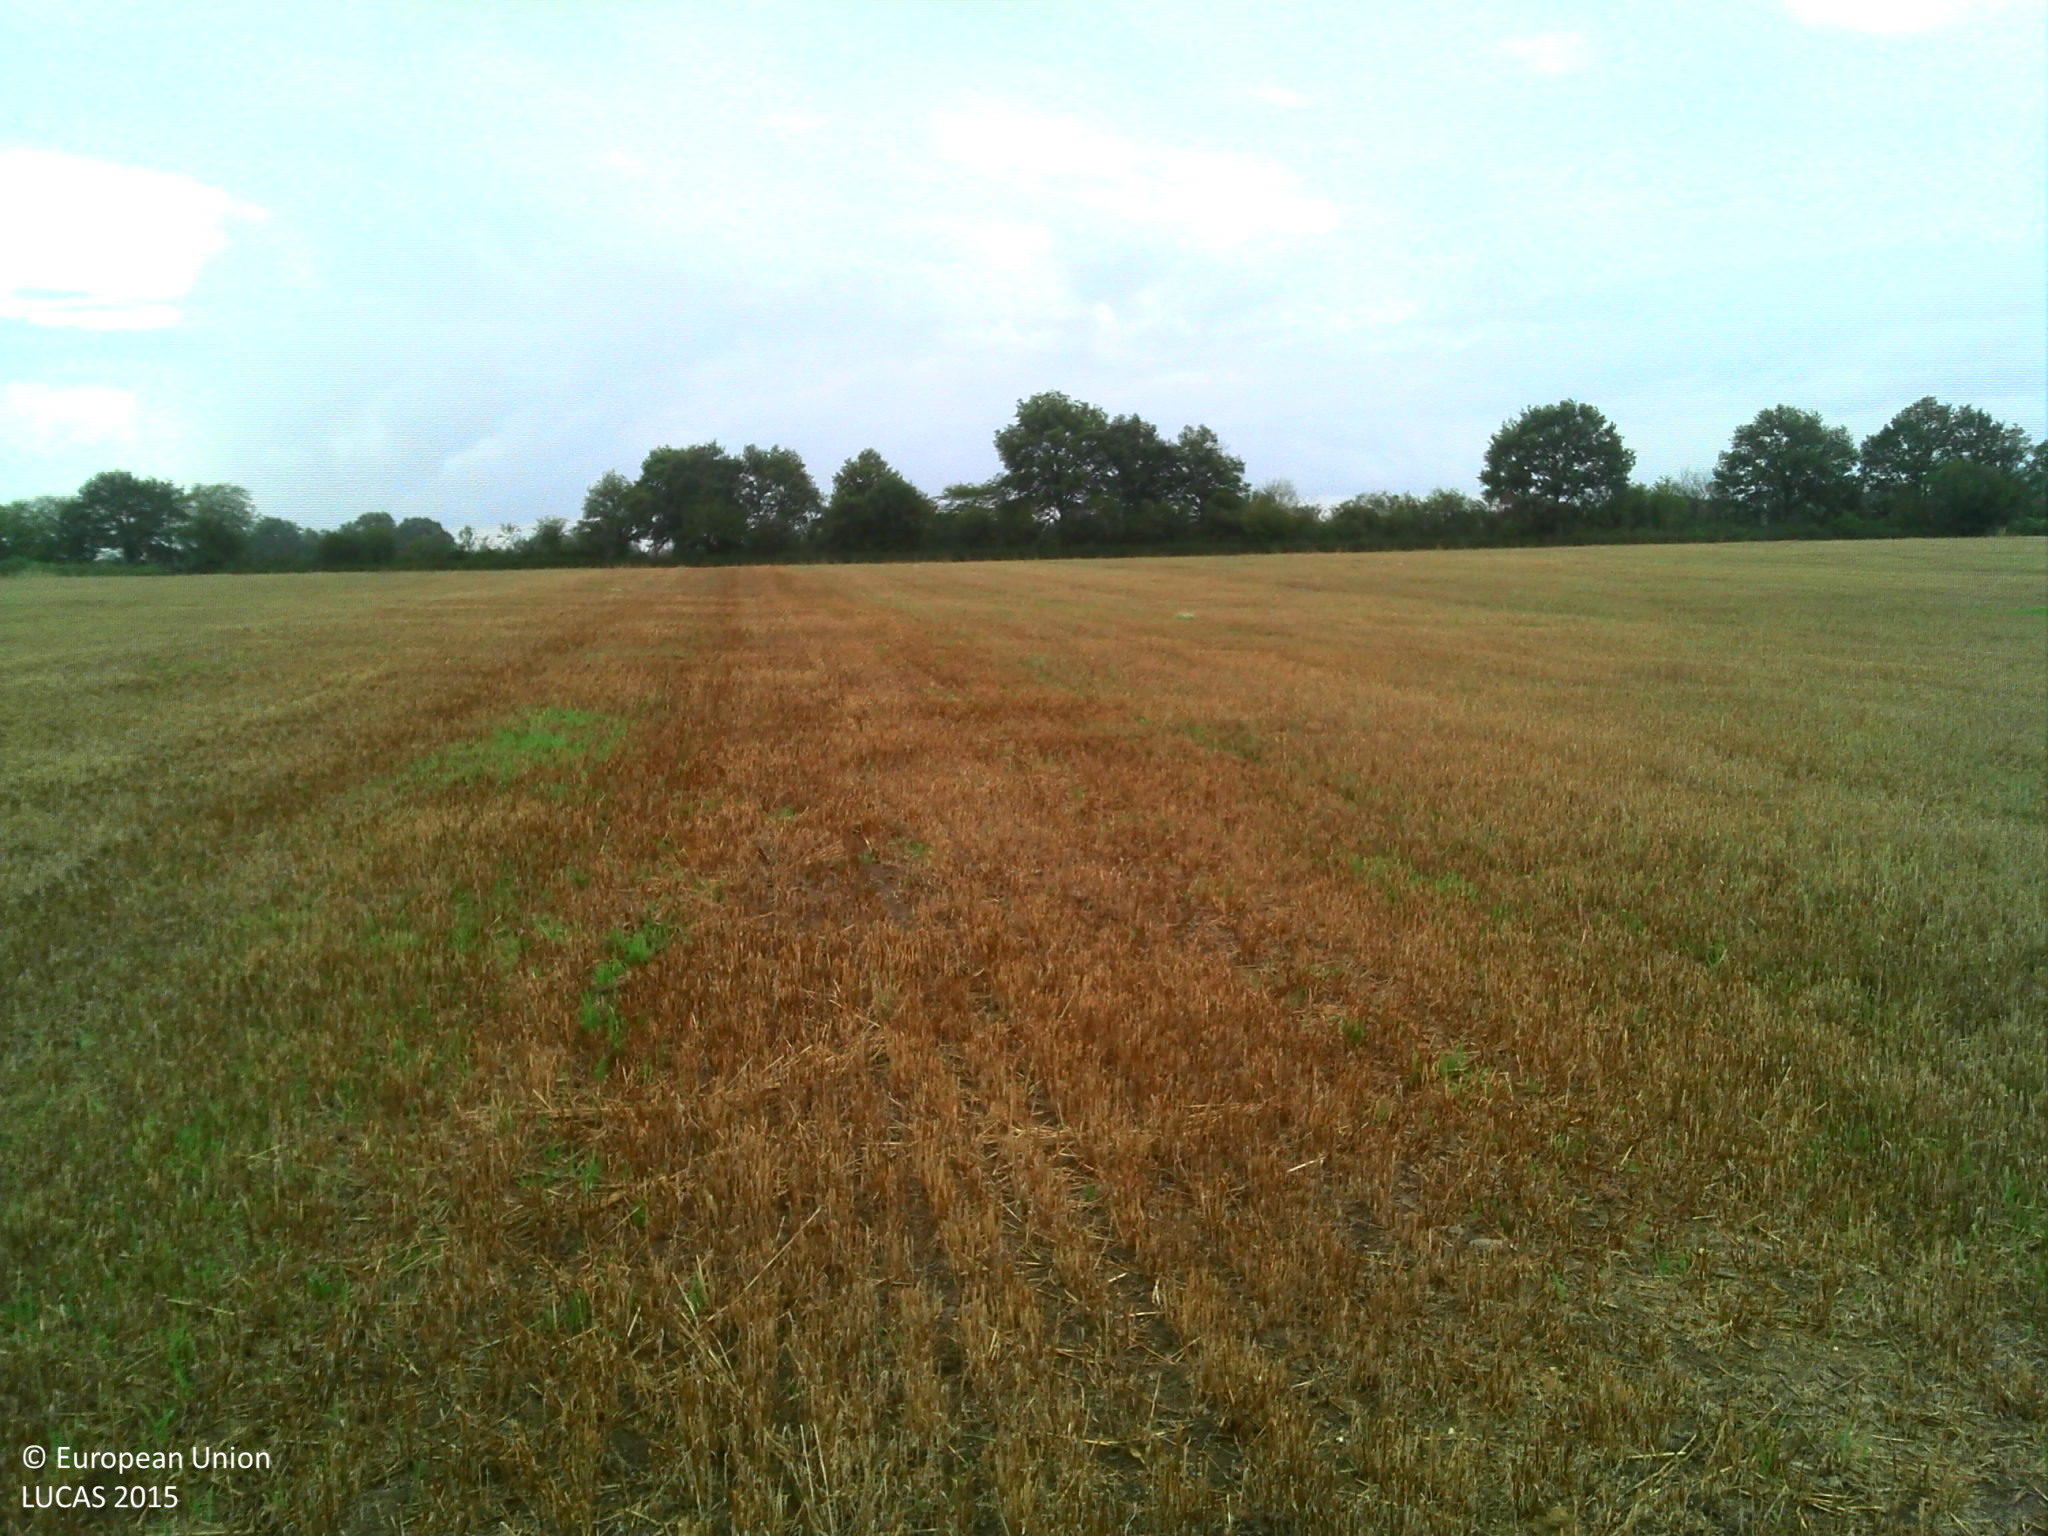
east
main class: Cropland
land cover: Barley
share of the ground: 50 - 75 %
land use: Agriculture (excluding fallow land and kitchen gardens)
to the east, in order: Barley; Managed hedges; Tracks; Broadleaved woodland; Grassland without tree/shrub cover; Managed hedges; Fences; Grassland without tree/shrub cover
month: August
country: FR
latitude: 46.2403
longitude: 2.3567
